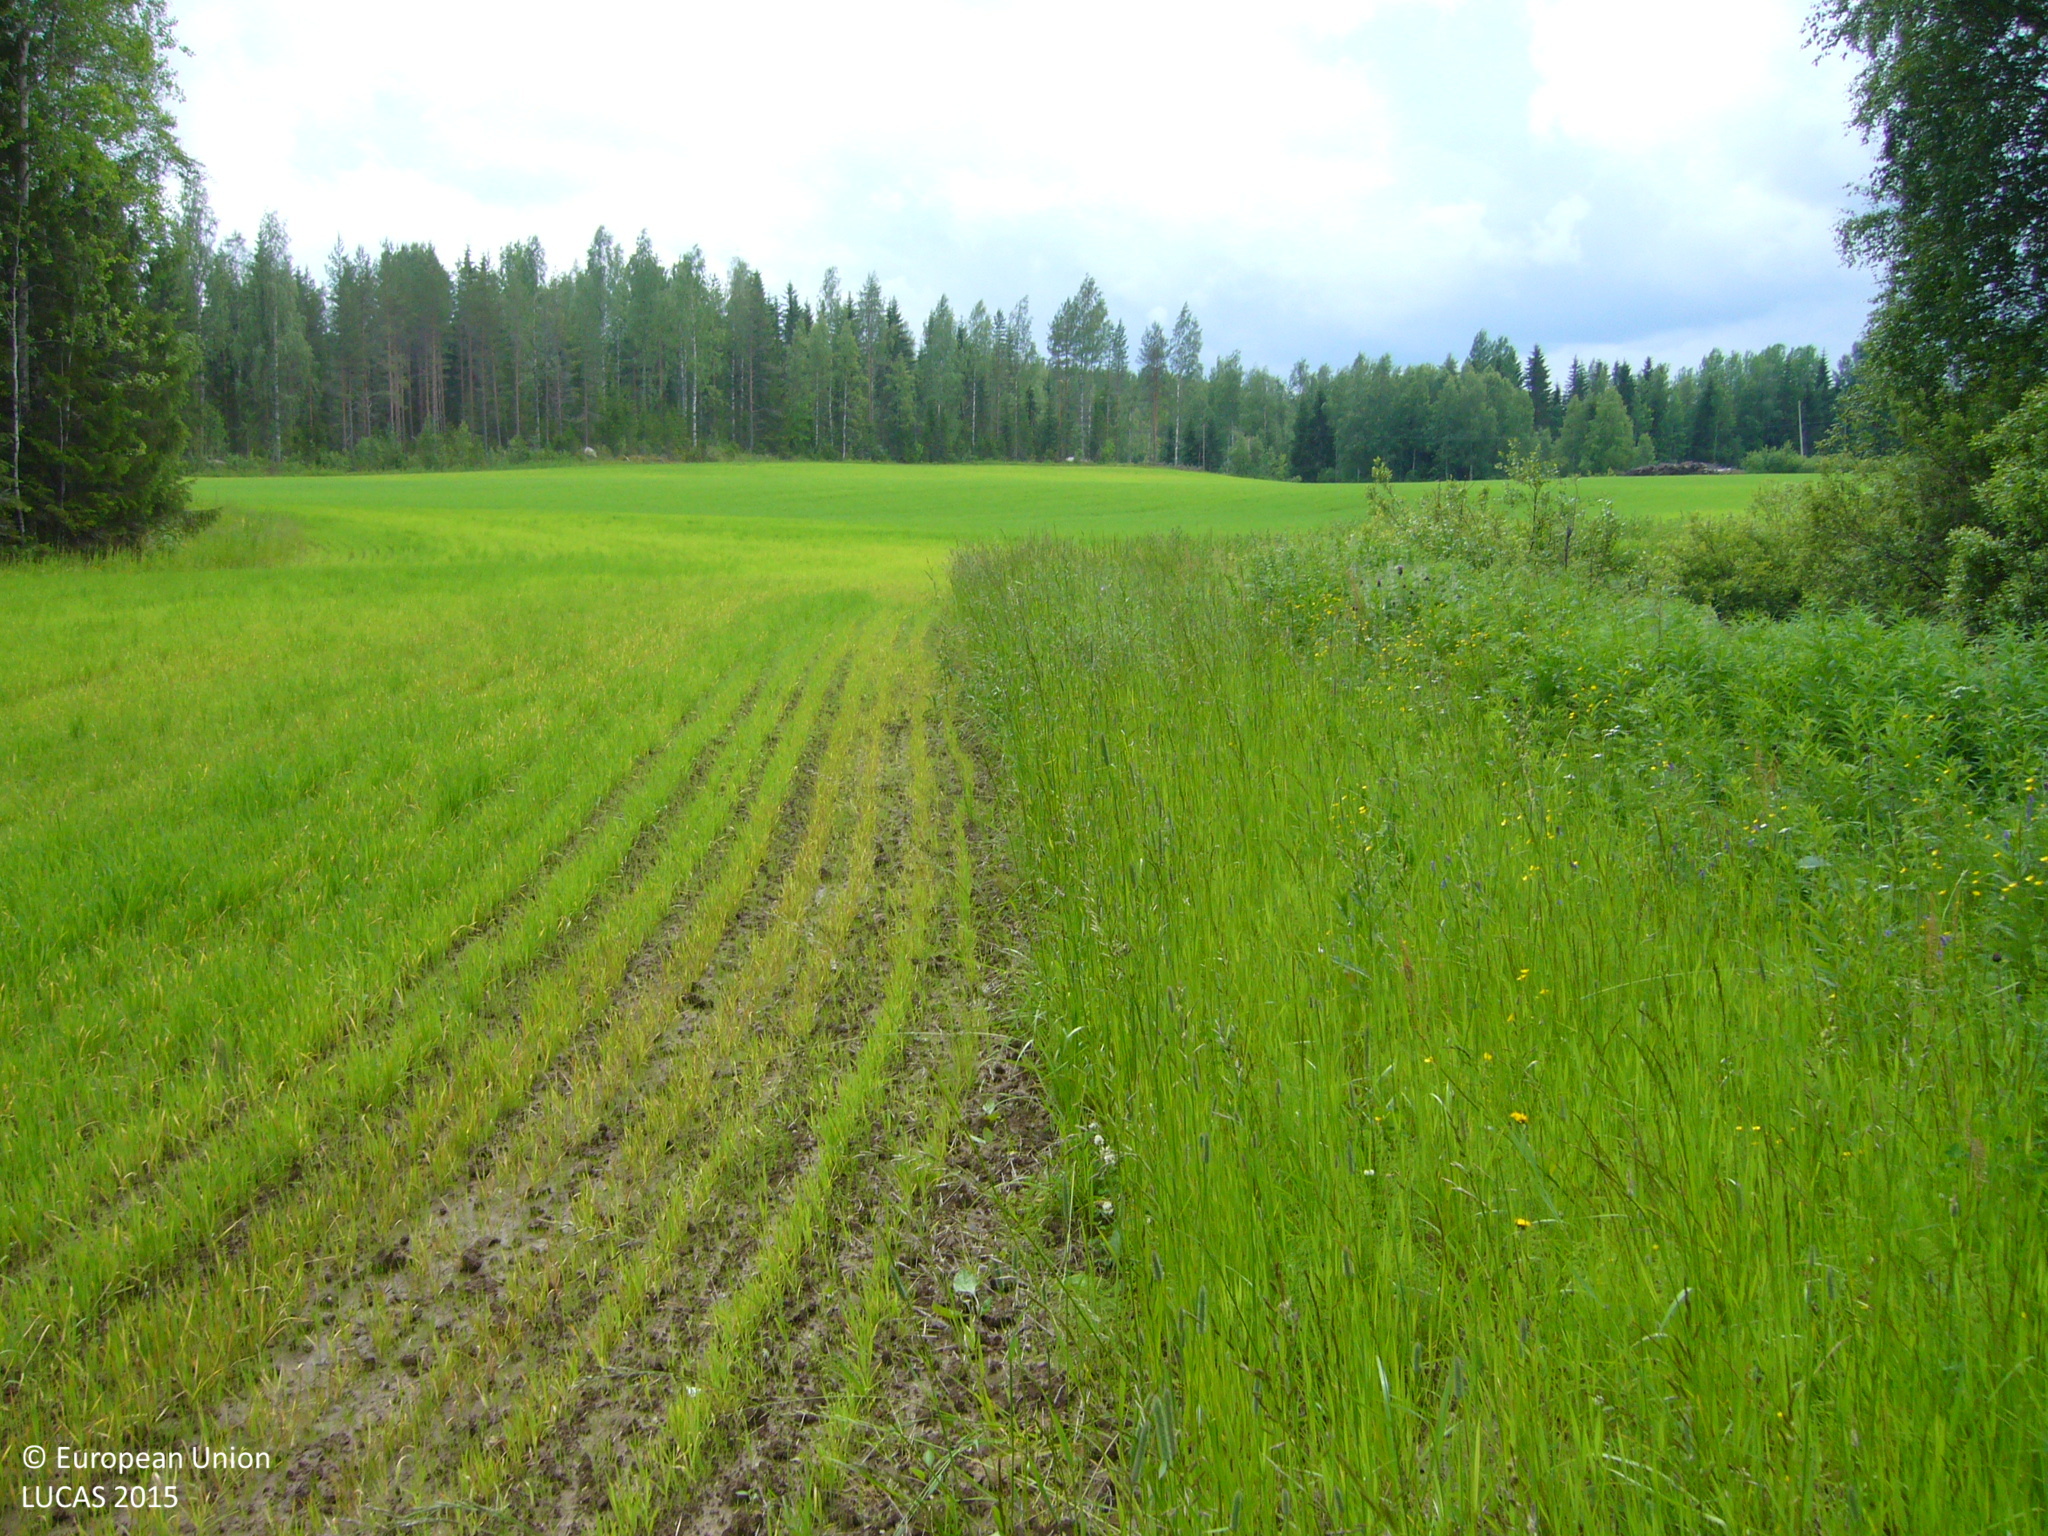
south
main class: Cropland
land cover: Barley
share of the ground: > 75 %
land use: Agriculture (excluding fallow land and kitchen gardens)
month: July
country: FI
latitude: 63.4452
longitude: 25.3153
